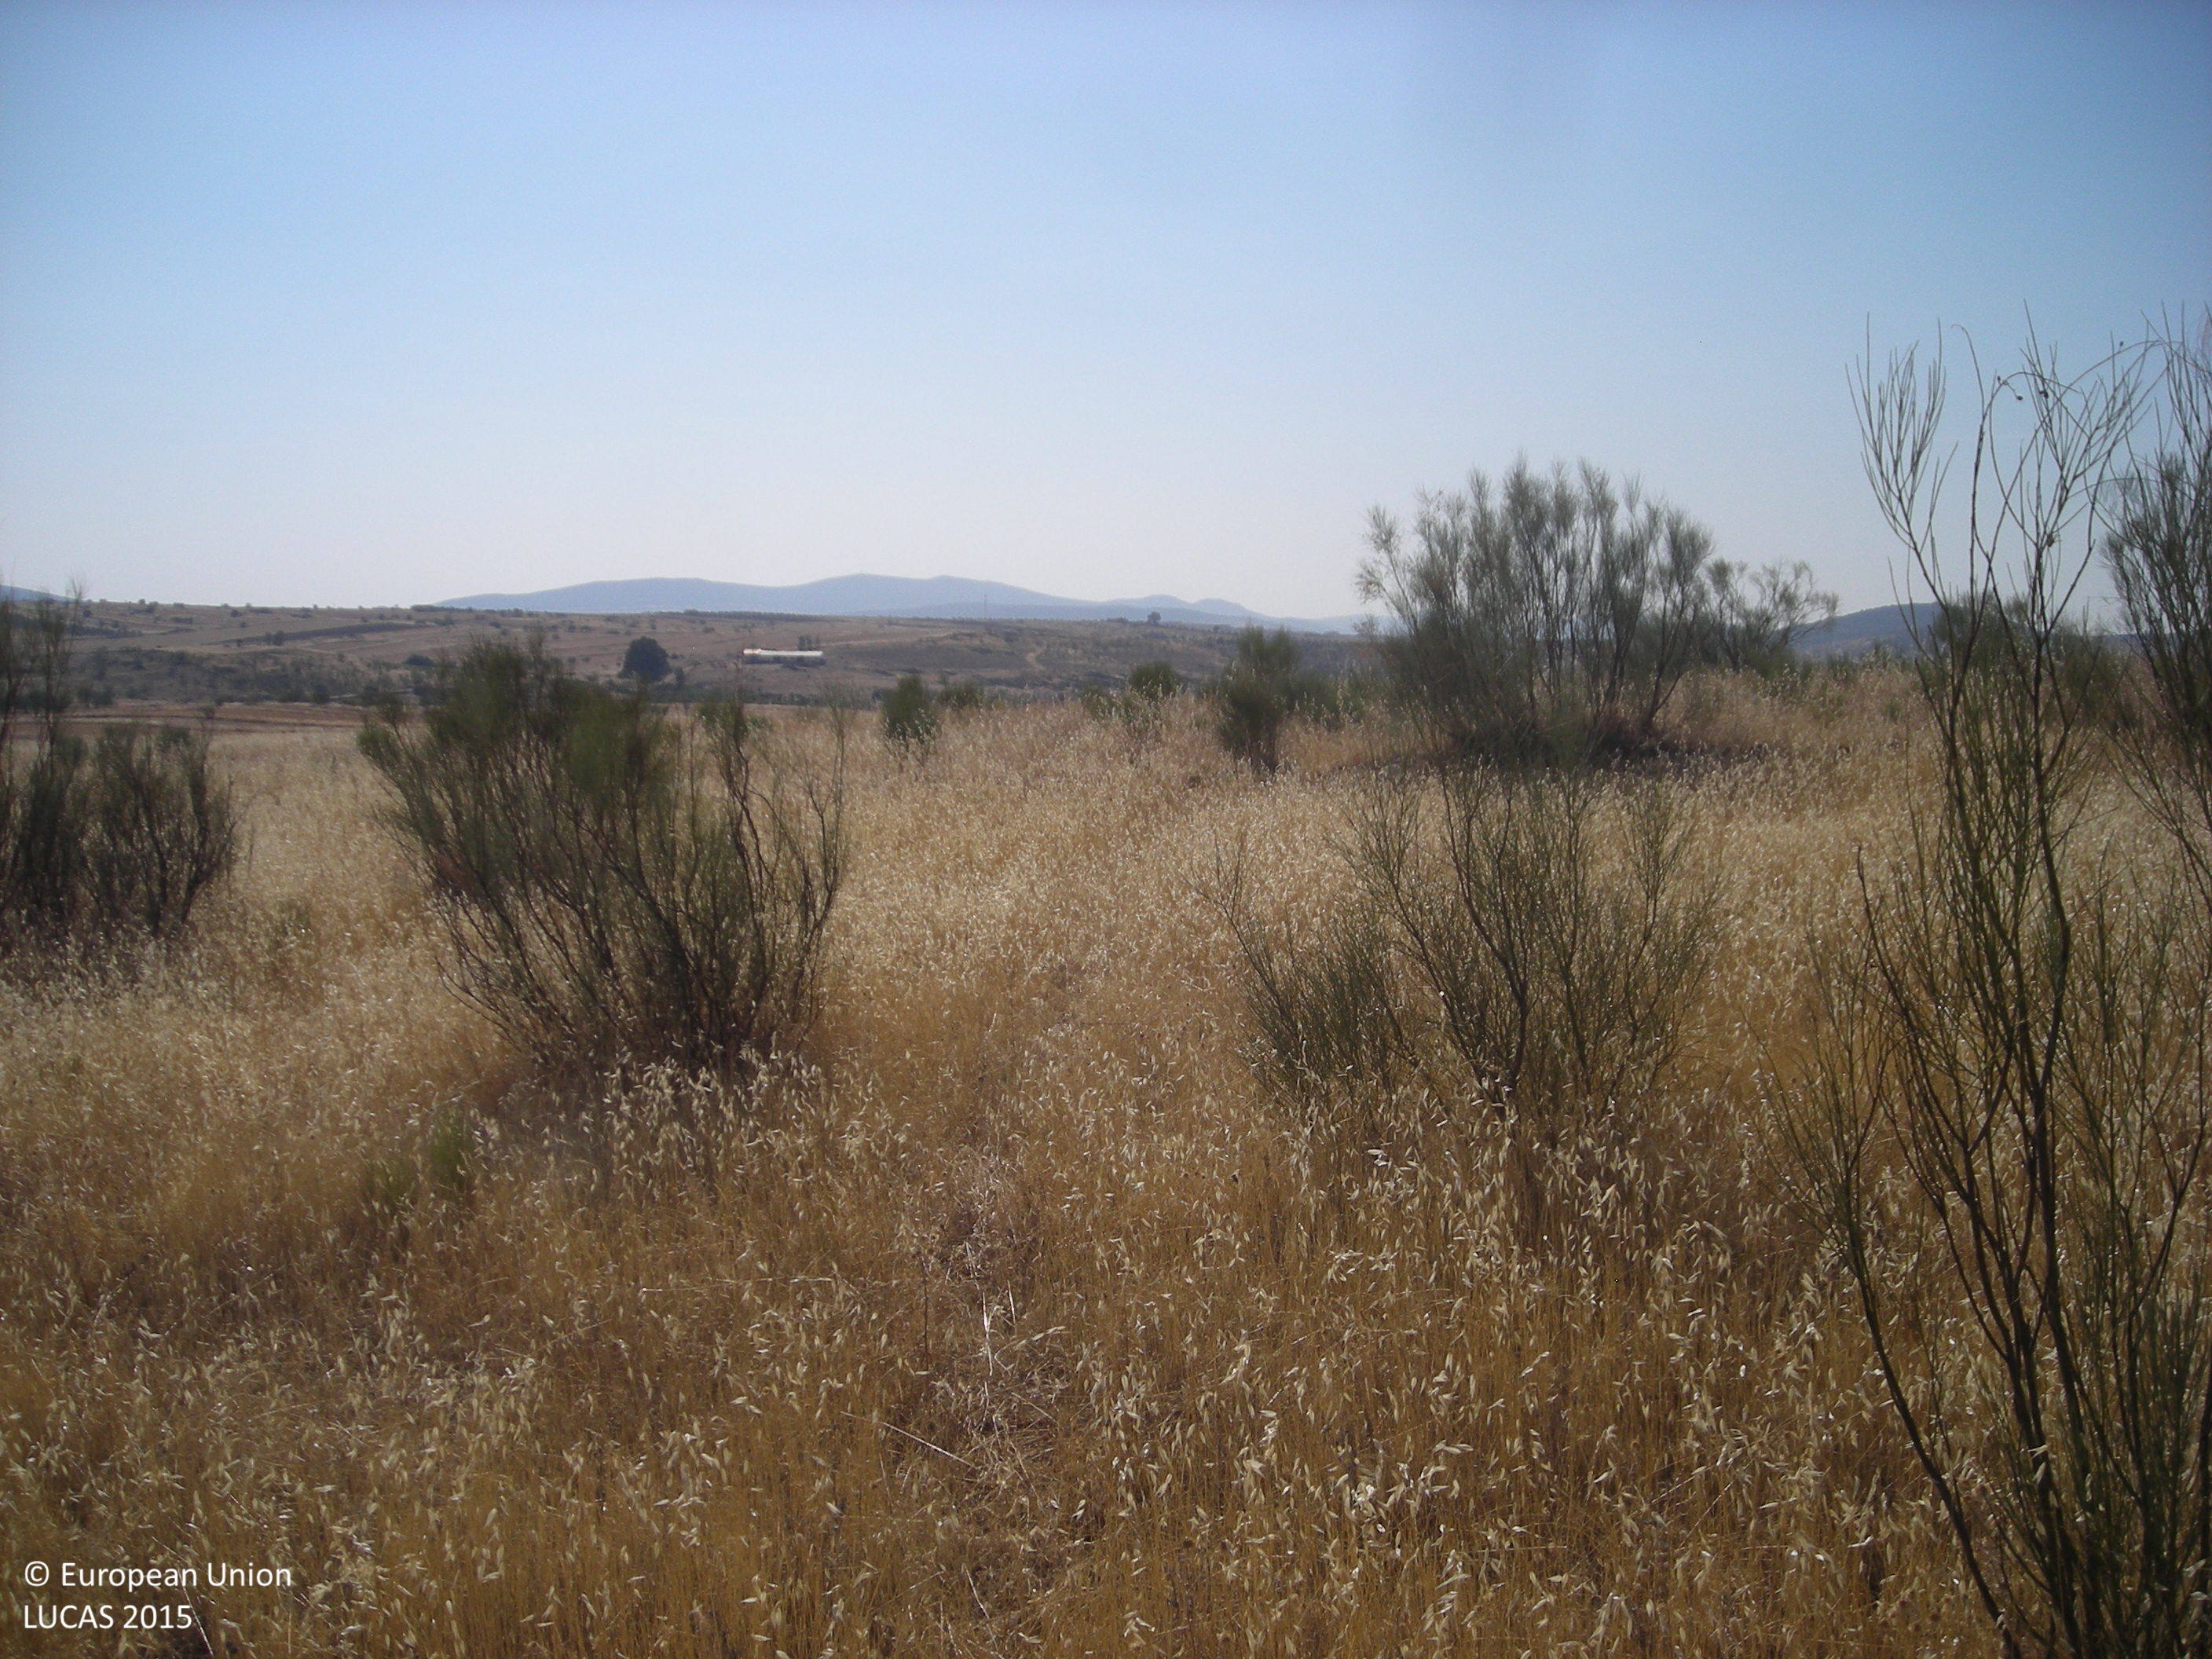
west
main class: Shrubland
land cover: Shrubland without tree cover
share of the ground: > 75 %
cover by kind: shrubs 100 %
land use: Agriculture (excluding fallow land and kitchen gardens)
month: July
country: ES
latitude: 38.6903
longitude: -5.7590
